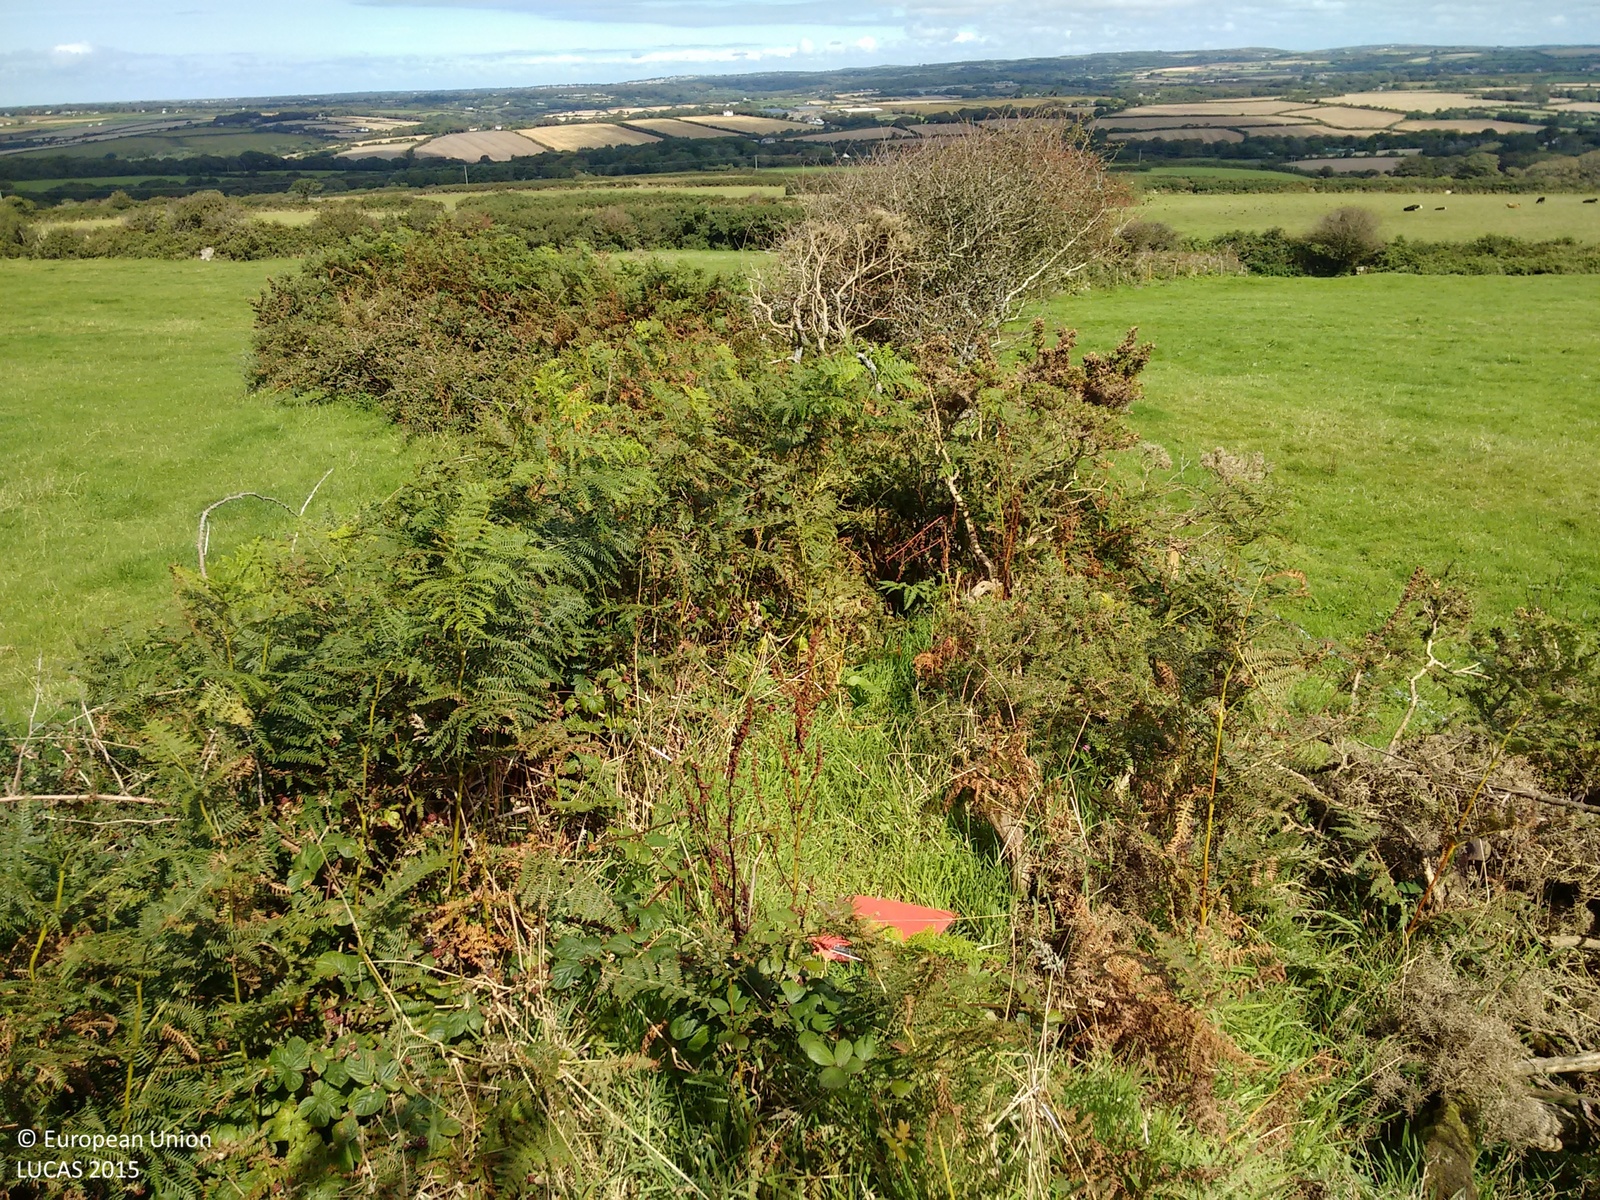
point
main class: Shrubland
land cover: Shrubland without tree cover
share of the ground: > 75 %
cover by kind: shrubs 70 %, herbaceous plants 30 %
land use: Agriculture (excluding fallow land and kitchen gardens)
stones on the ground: < 10 %
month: September
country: GB
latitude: 50.1244
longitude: -5.3562
